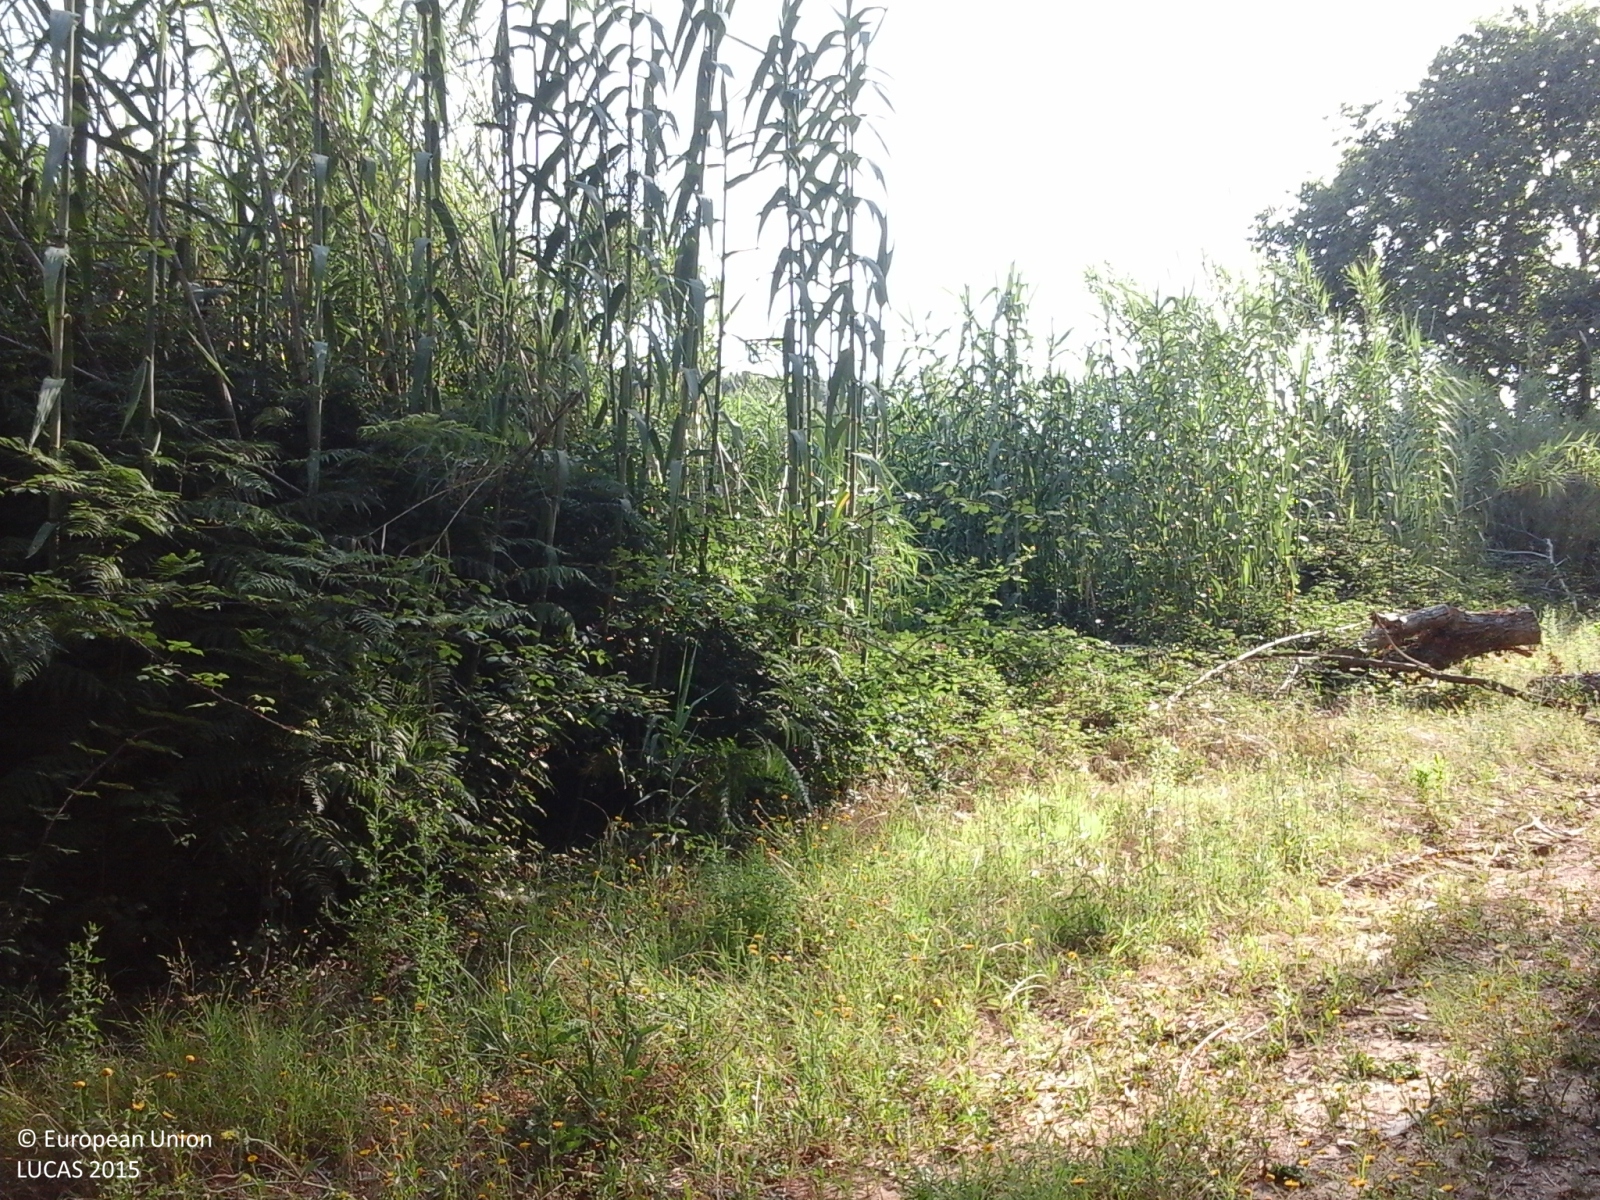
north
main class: Grassland
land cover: Grassland with sparse tree/shrub cover
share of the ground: > 75 %
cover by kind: herbaceous plants 85 %, shrubs 10 %, coniferous forest trees 5 %
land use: Agriculture (excluding fallow land and kitchen gardens)
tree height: > 5 m
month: July
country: IT
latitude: 43.3021
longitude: 10.6268
